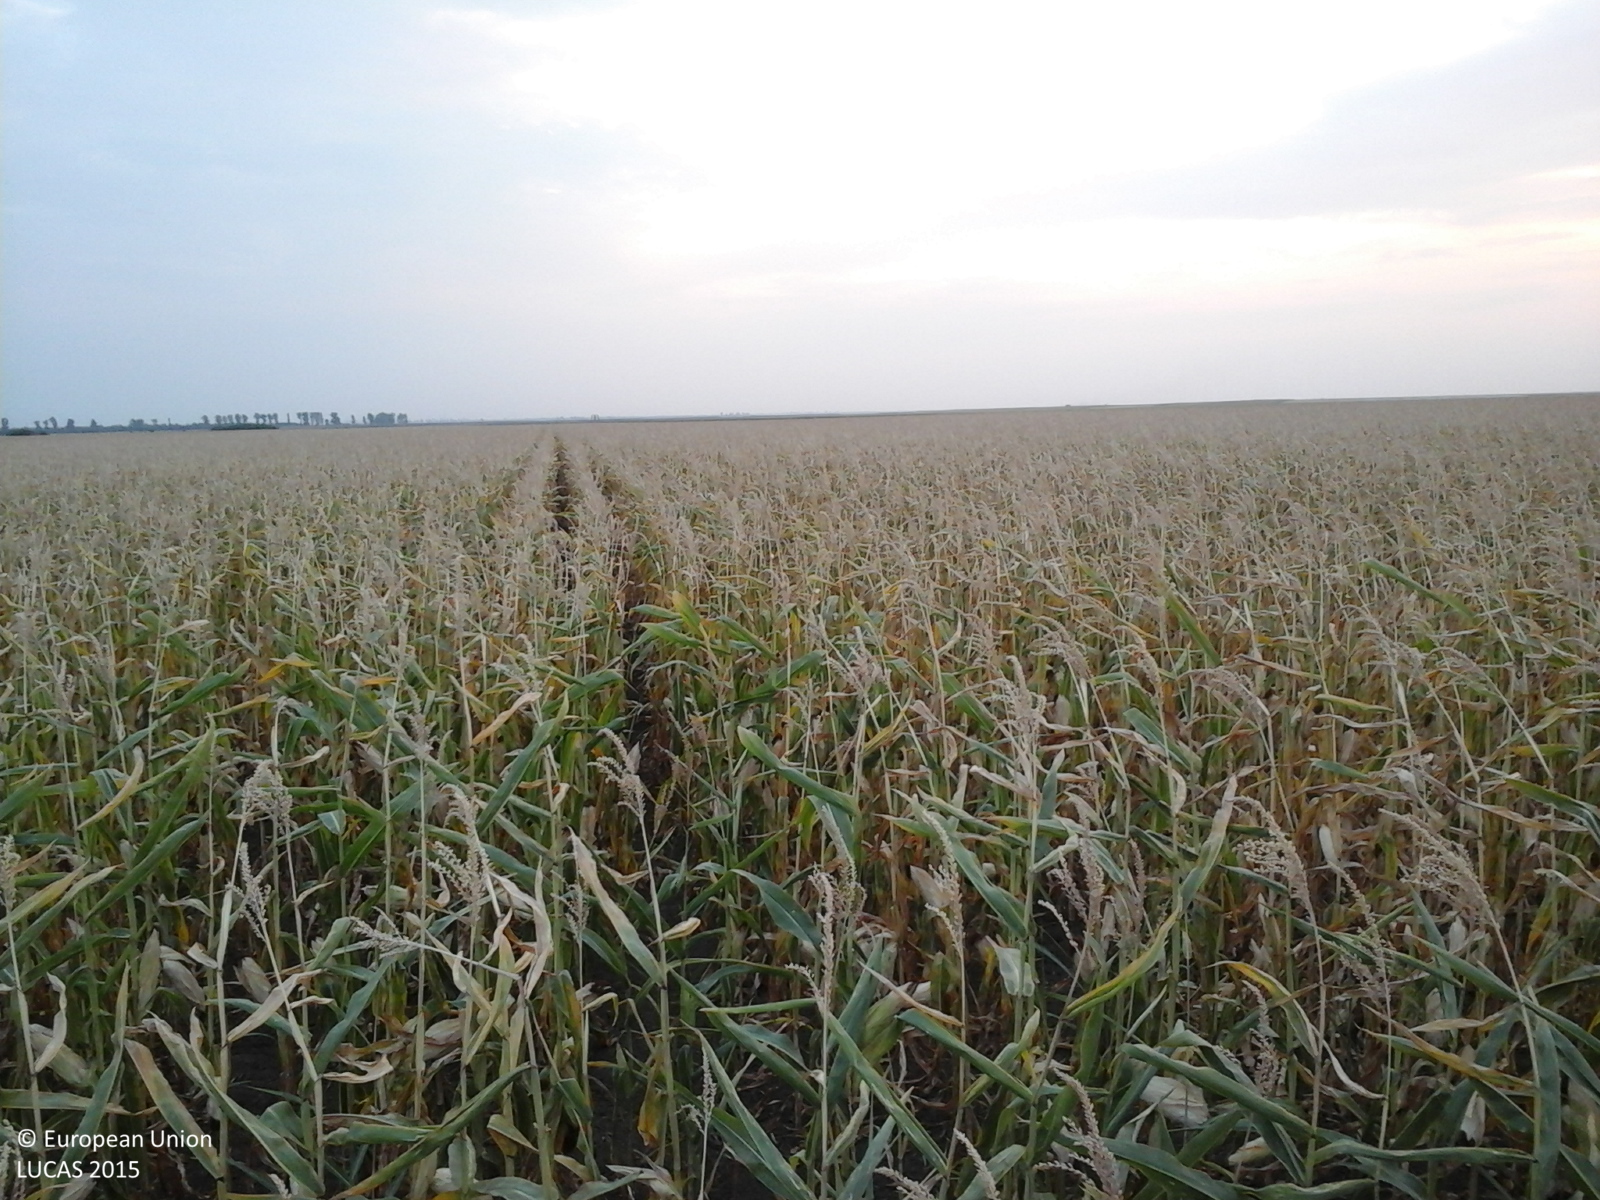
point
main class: Cropland
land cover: Maize
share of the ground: > 75 %
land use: Agriculture (excluding fallow land and kitchen gardens)
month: August
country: RO
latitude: 45.0142
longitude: 27.4419
